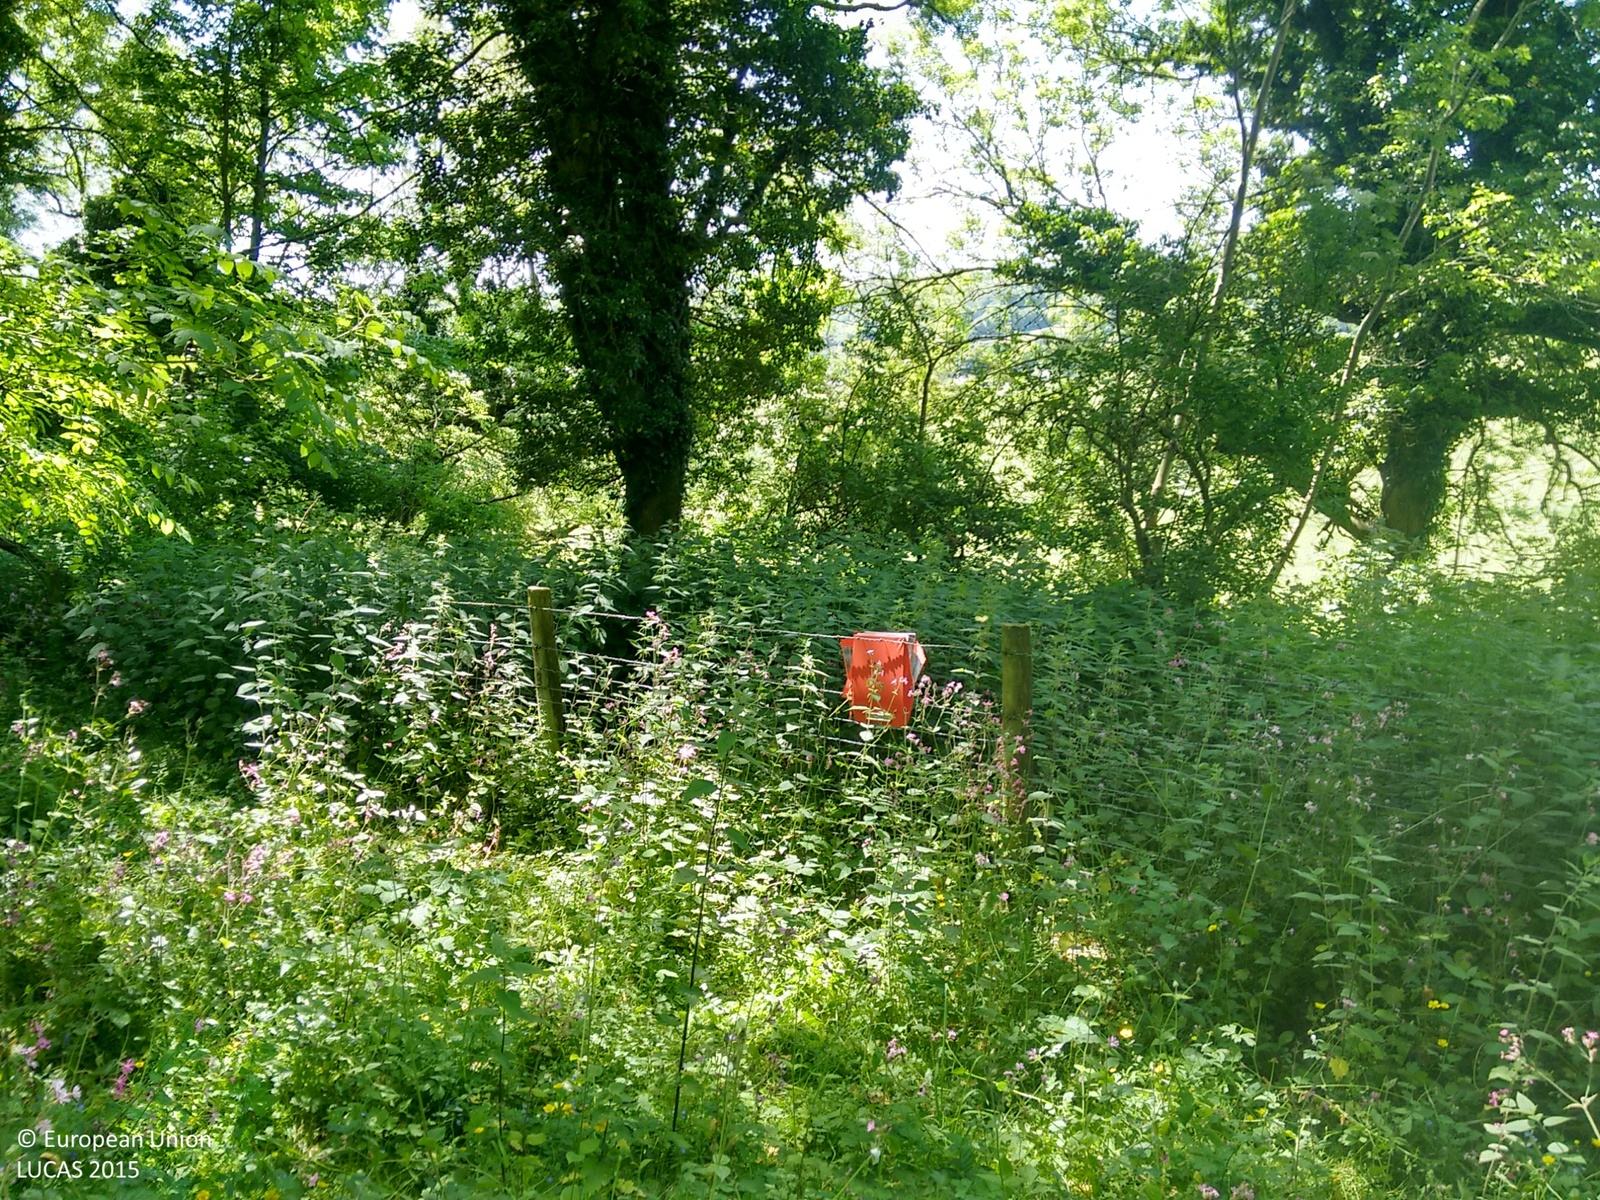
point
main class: Woodland
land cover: Broadleaved woodland
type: mesophytic deciduous forest
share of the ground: > 75 %
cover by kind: broadleaved forest trees 75 %, shrubs 15 %, herbaceous plants 10 %
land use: Semi-natural and natural areas not in use
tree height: > 5 m
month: June
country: GB
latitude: 50.7956
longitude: 0.2229
